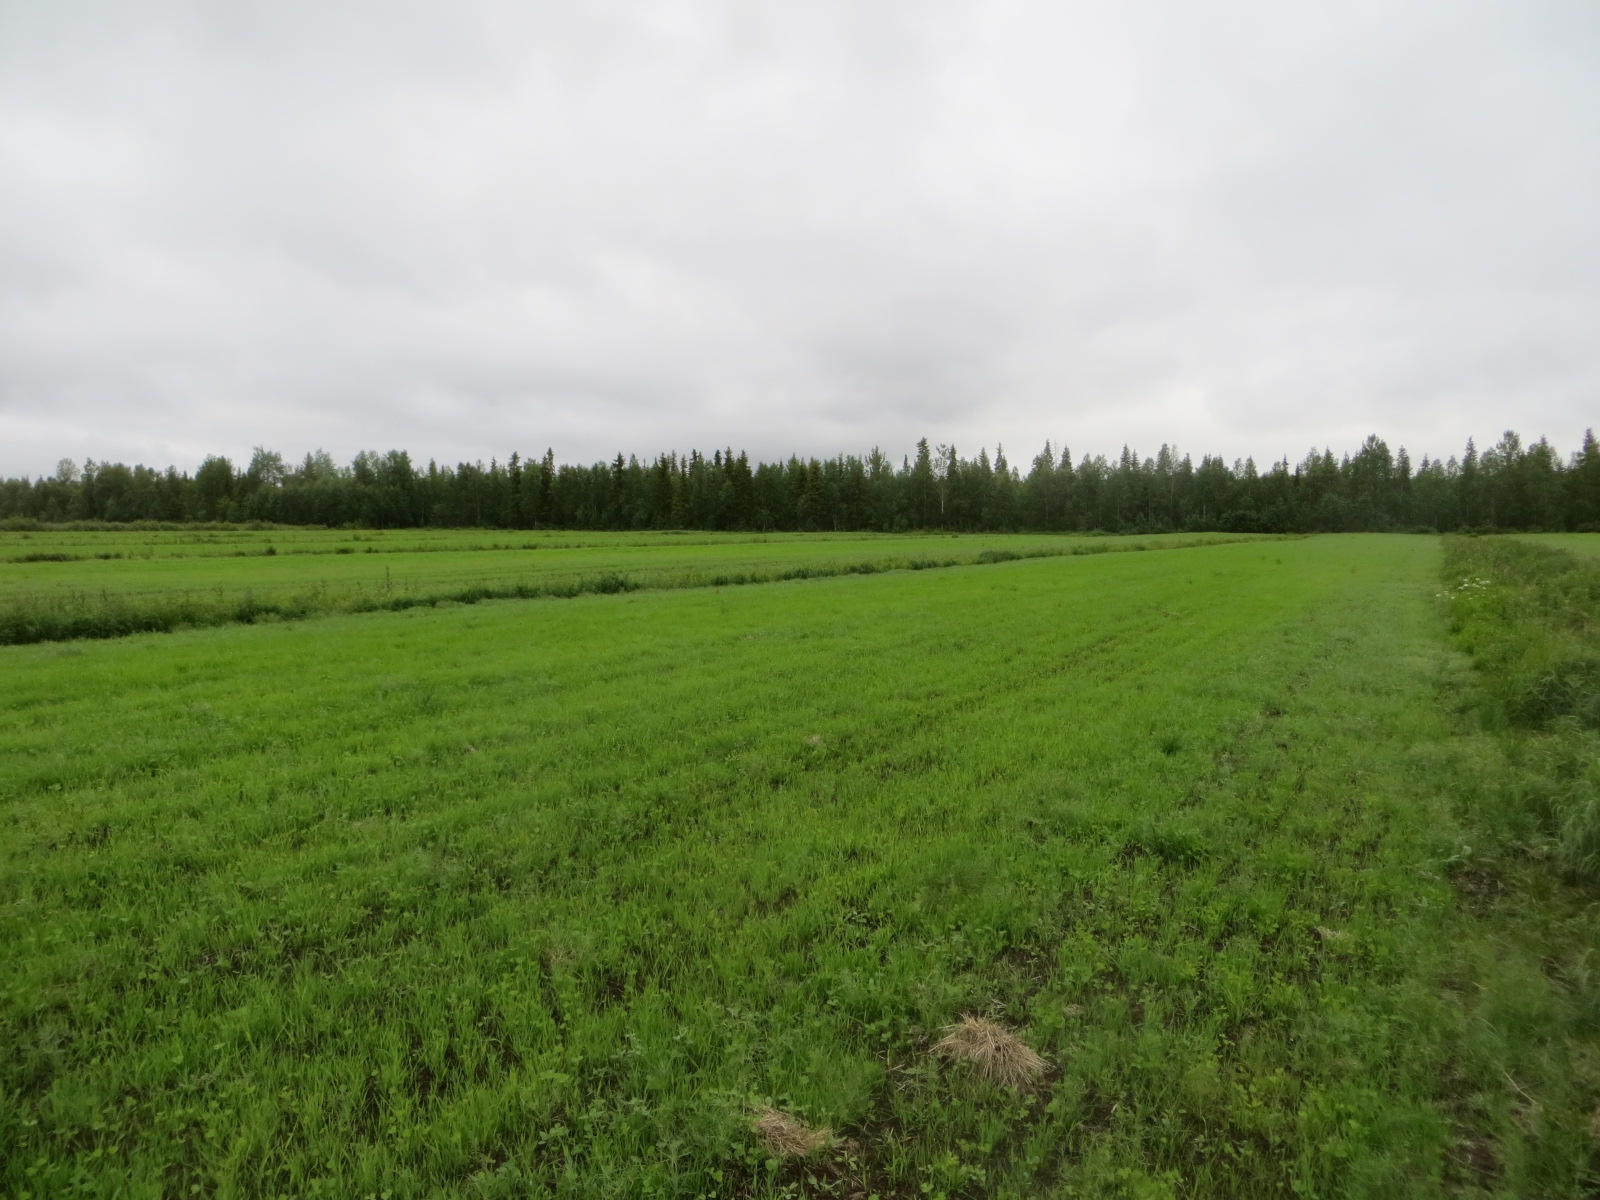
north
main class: Cropland
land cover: Temporary grasslands
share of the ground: 25 - 50 %
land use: Agriculture (excluding fallow land and kitchen gardens)
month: July
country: FI
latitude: 66.3943
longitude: 24.3892
